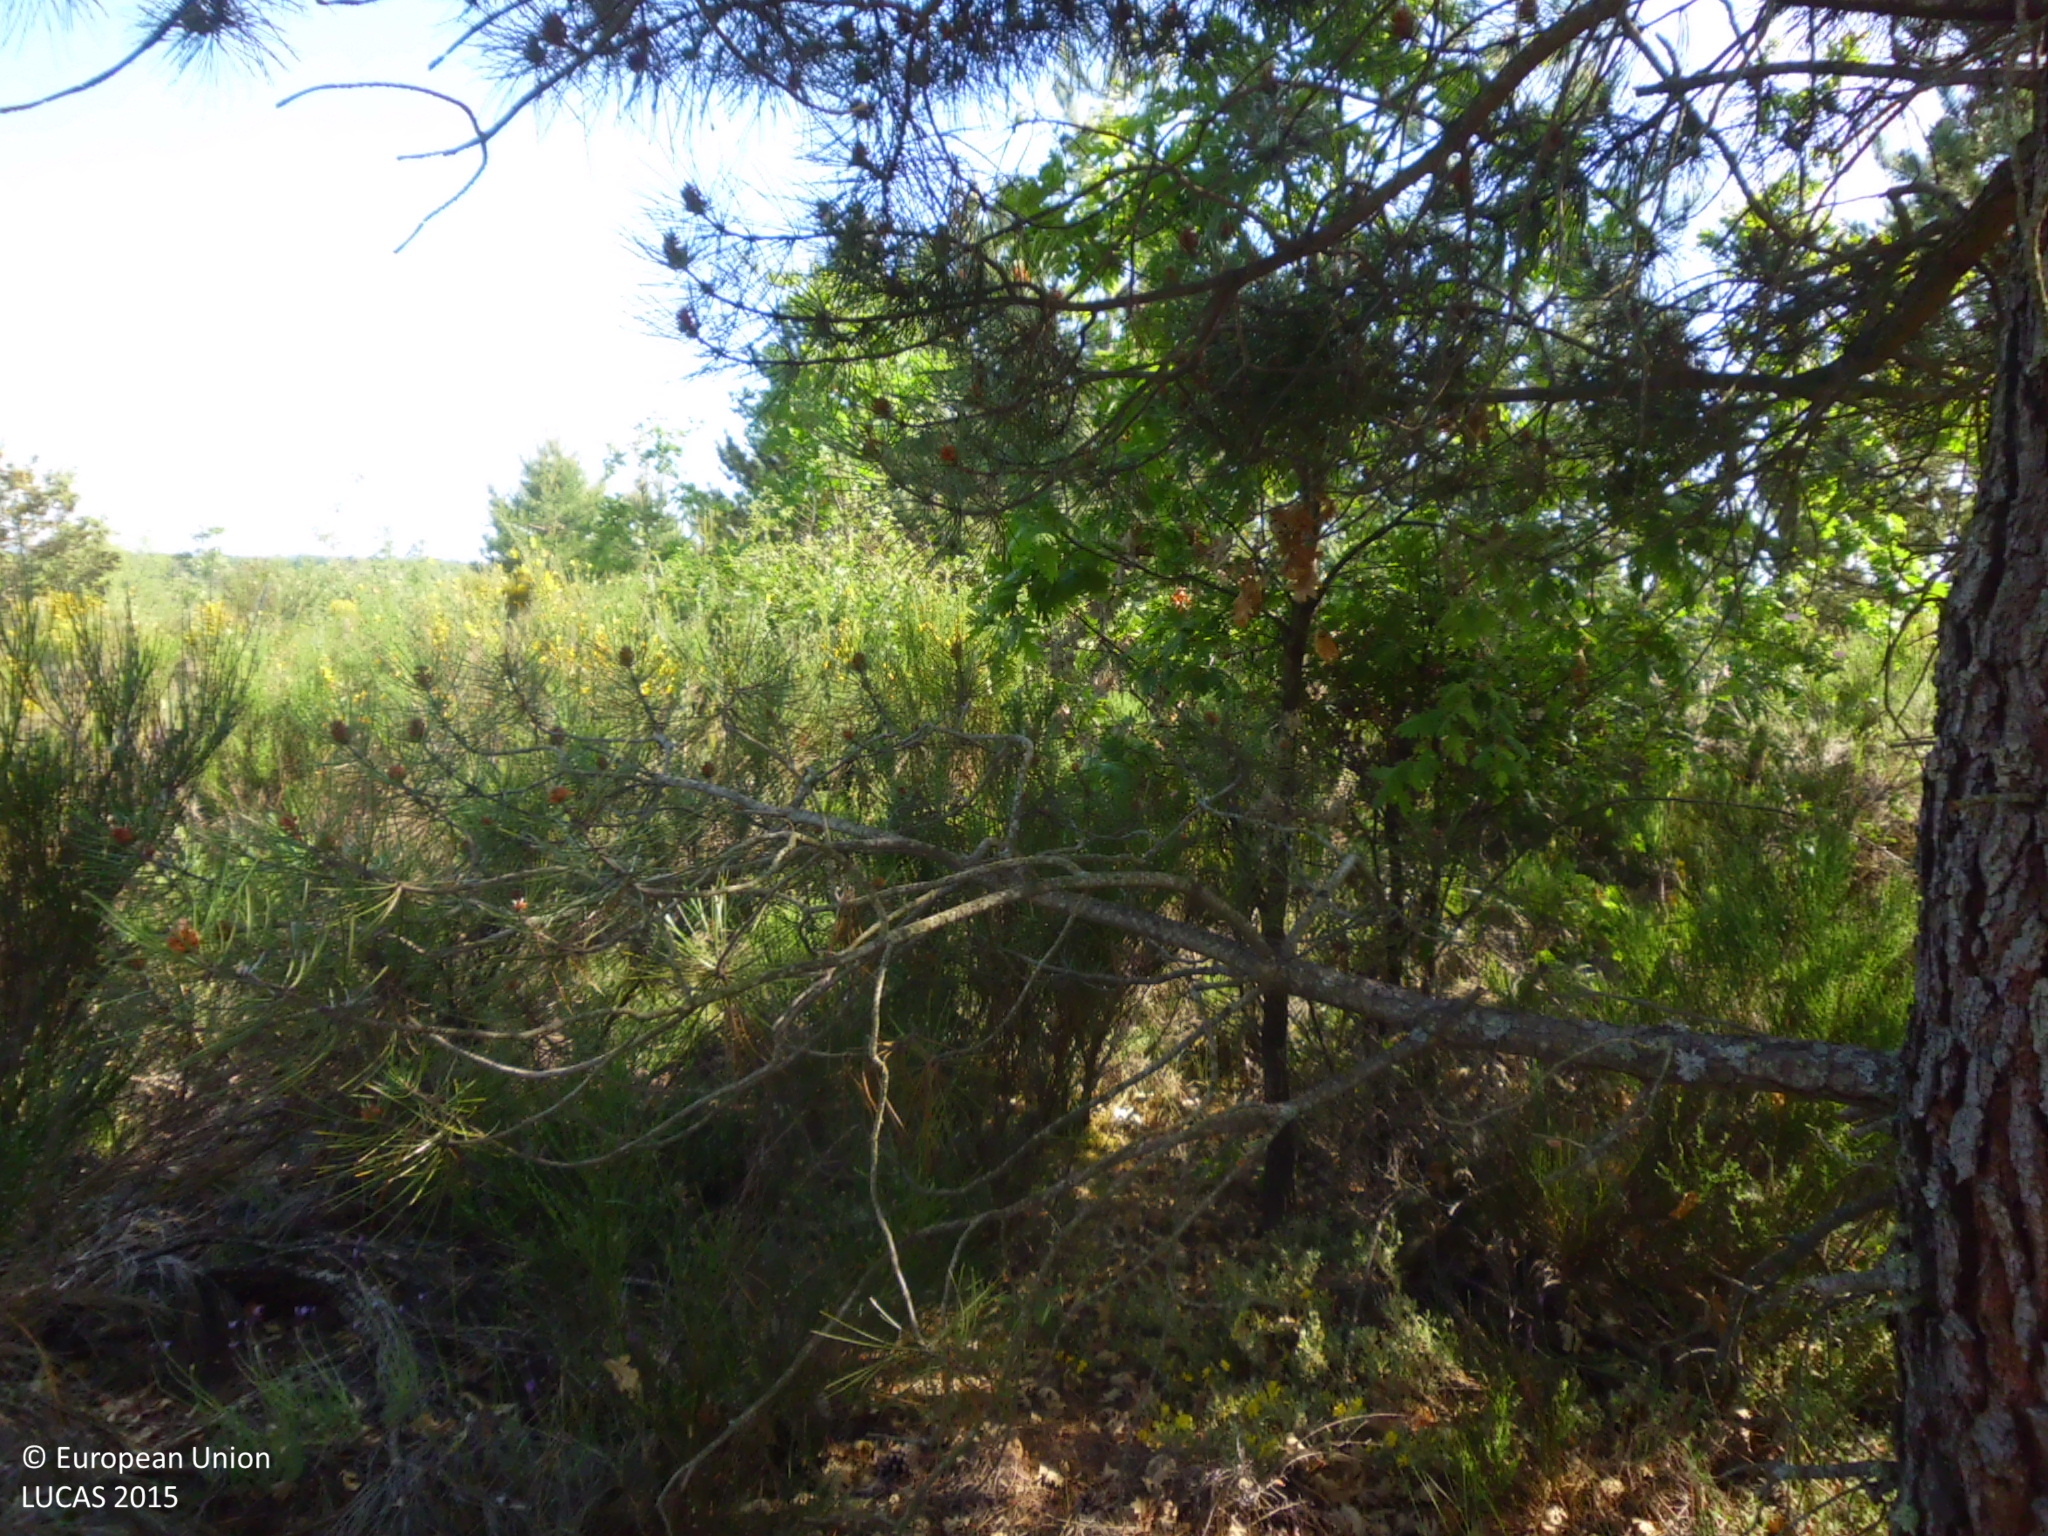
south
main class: Woodland
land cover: Pine dominated mixed woodland
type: coniferous forest of the mediterranean region
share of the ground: 50 - 75 %
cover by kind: coniferous forest trees 45 %, broadleaved forest trees 25 %, herbaceous plants 20 %, shrubs 10 %
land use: Forestry
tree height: > 5 m
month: May
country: ES
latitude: 42.7129
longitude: -5.4190
